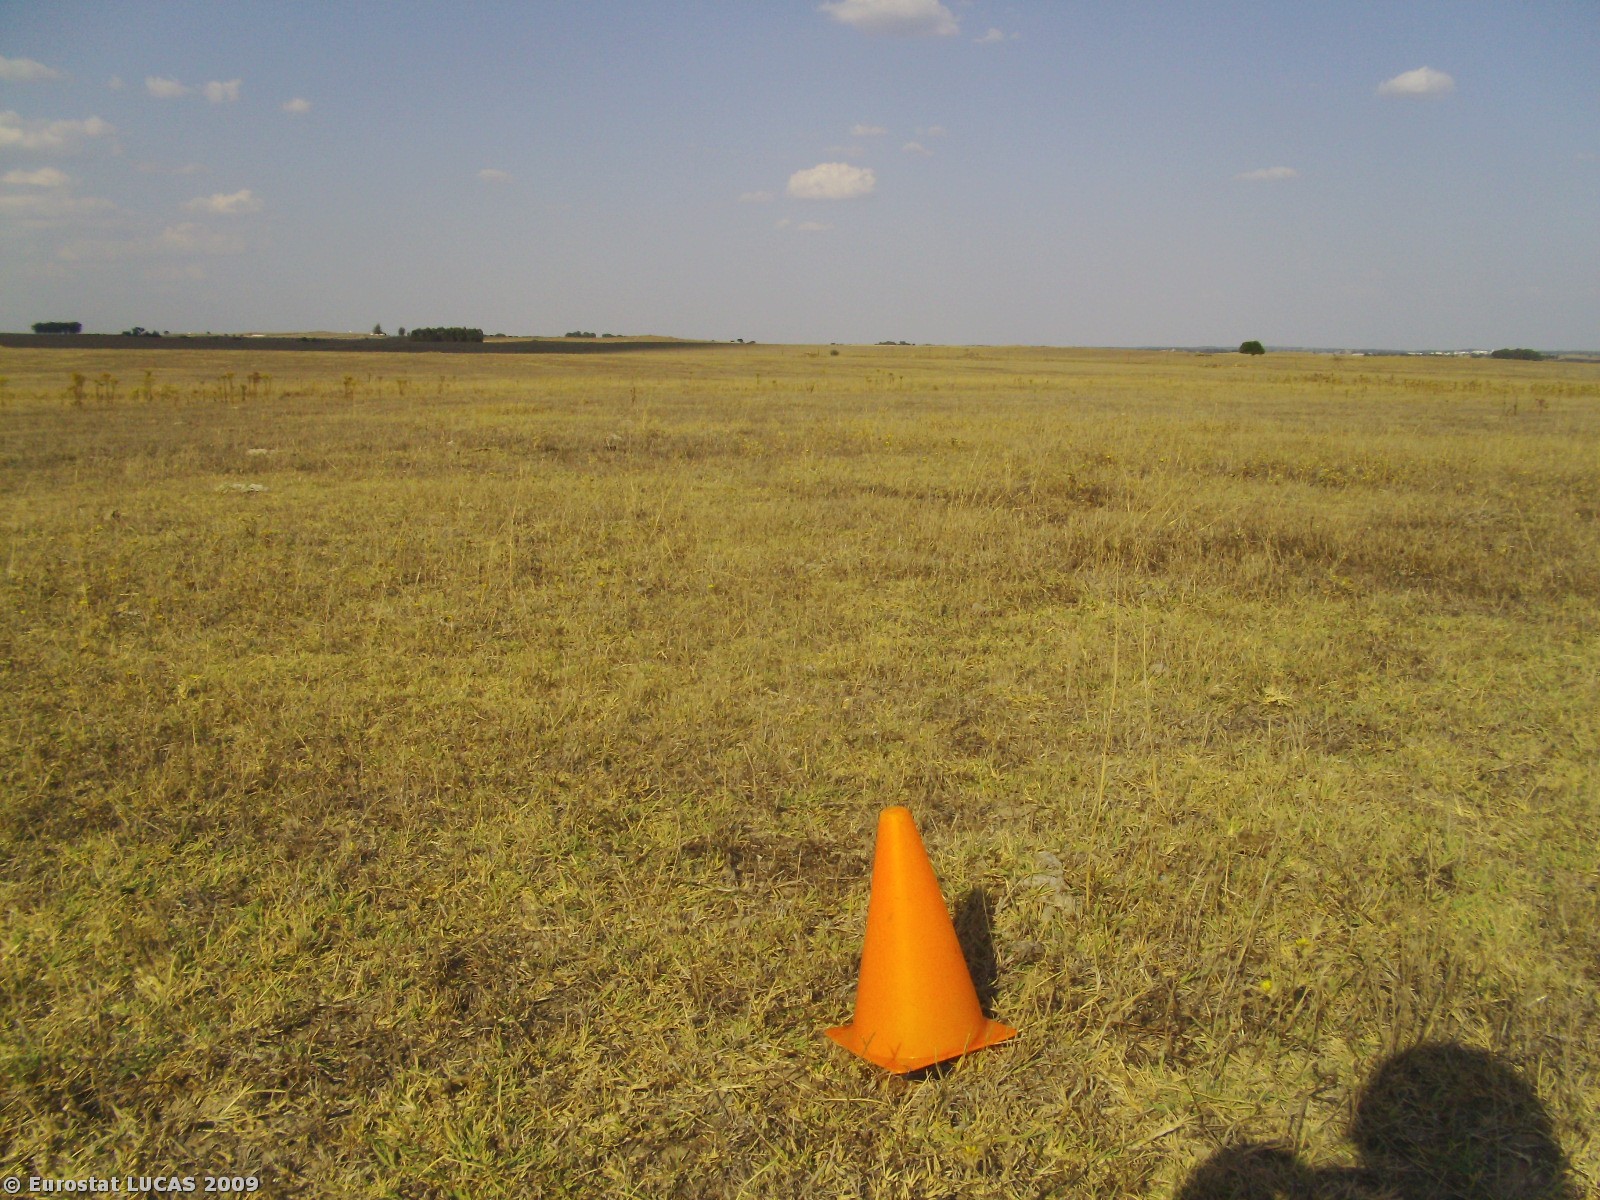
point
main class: Grassland
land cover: Grassland without tree/shrub cover
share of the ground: > 75 %
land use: Agriculture (excluding fallow land and kitchen gardens)
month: August
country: PT
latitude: 38.3926
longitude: -8.0494
